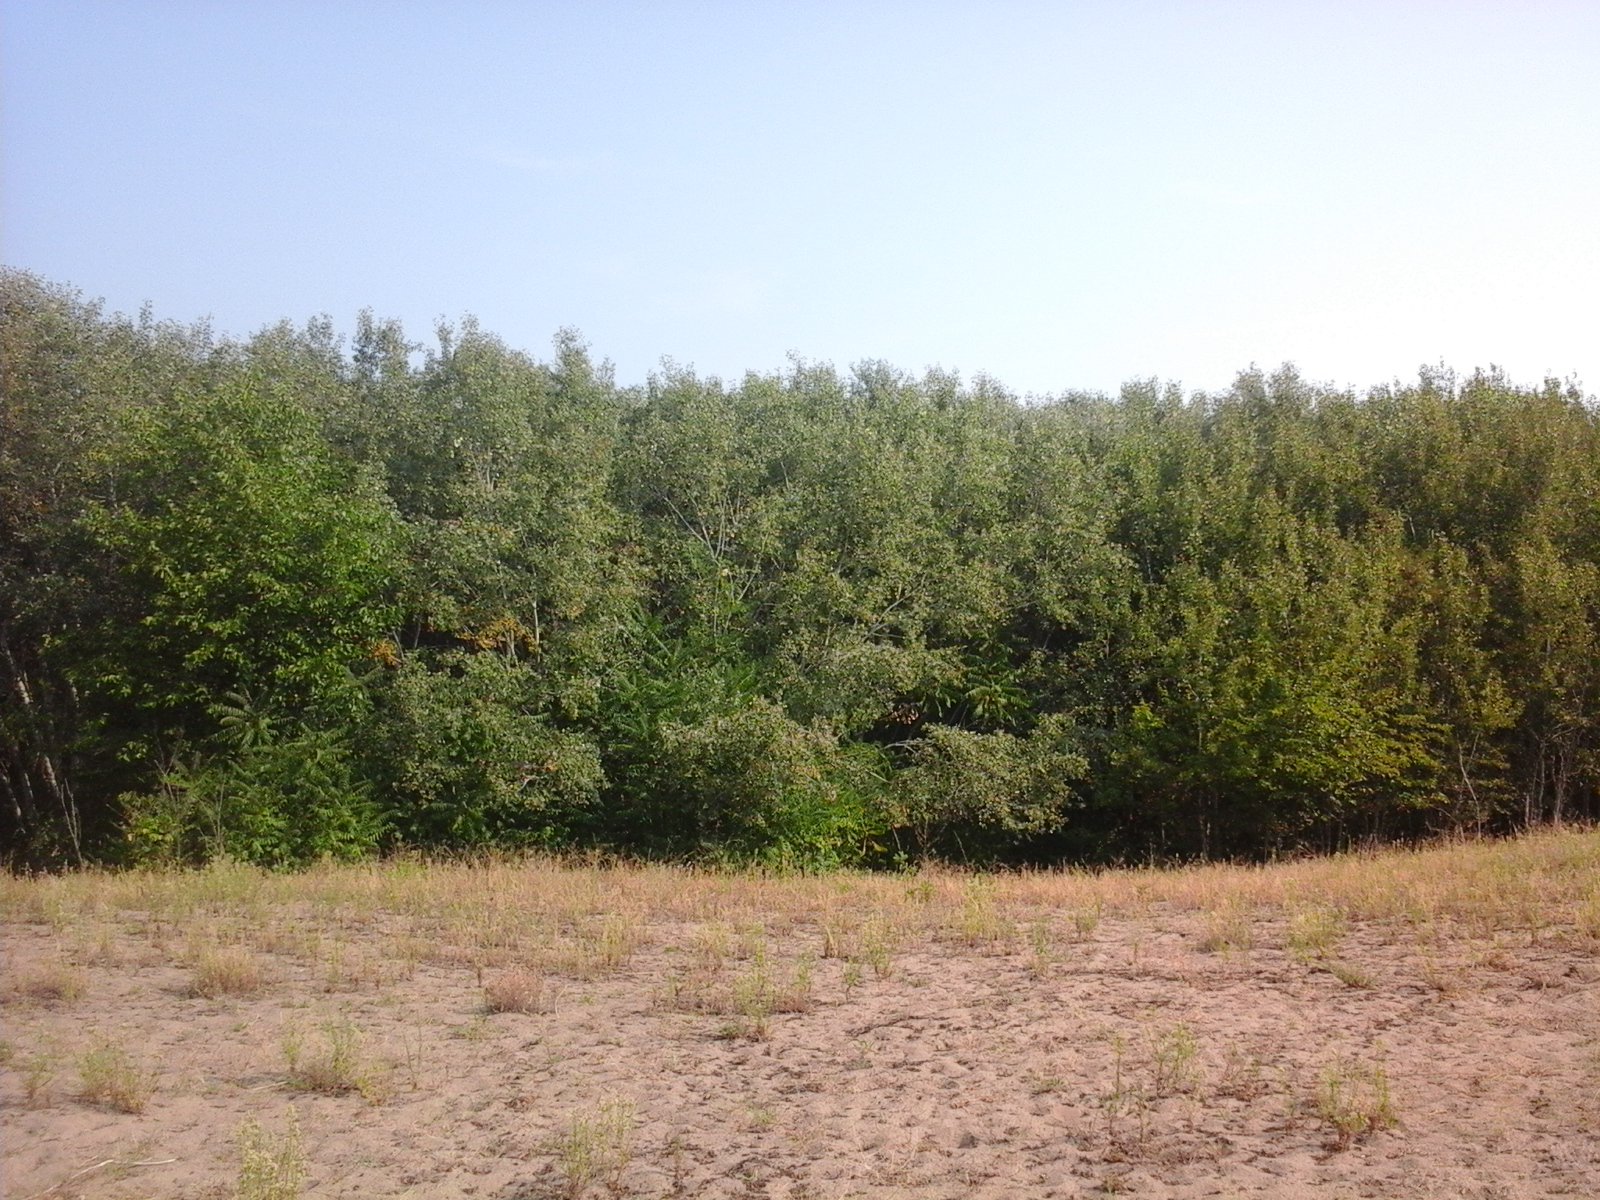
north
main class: Grassland
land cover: Grassland with sparse tree/shrub cover
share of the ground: > 75 %
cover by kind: herbaceous plants 85 %, shrubs 10 %, broadleaved forest trees 5 %
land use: Agriculture (excluding fallow land and kitchen gardens)
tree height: < 5 m
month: August
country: RO
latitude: 44.3011
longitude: 22.6612
